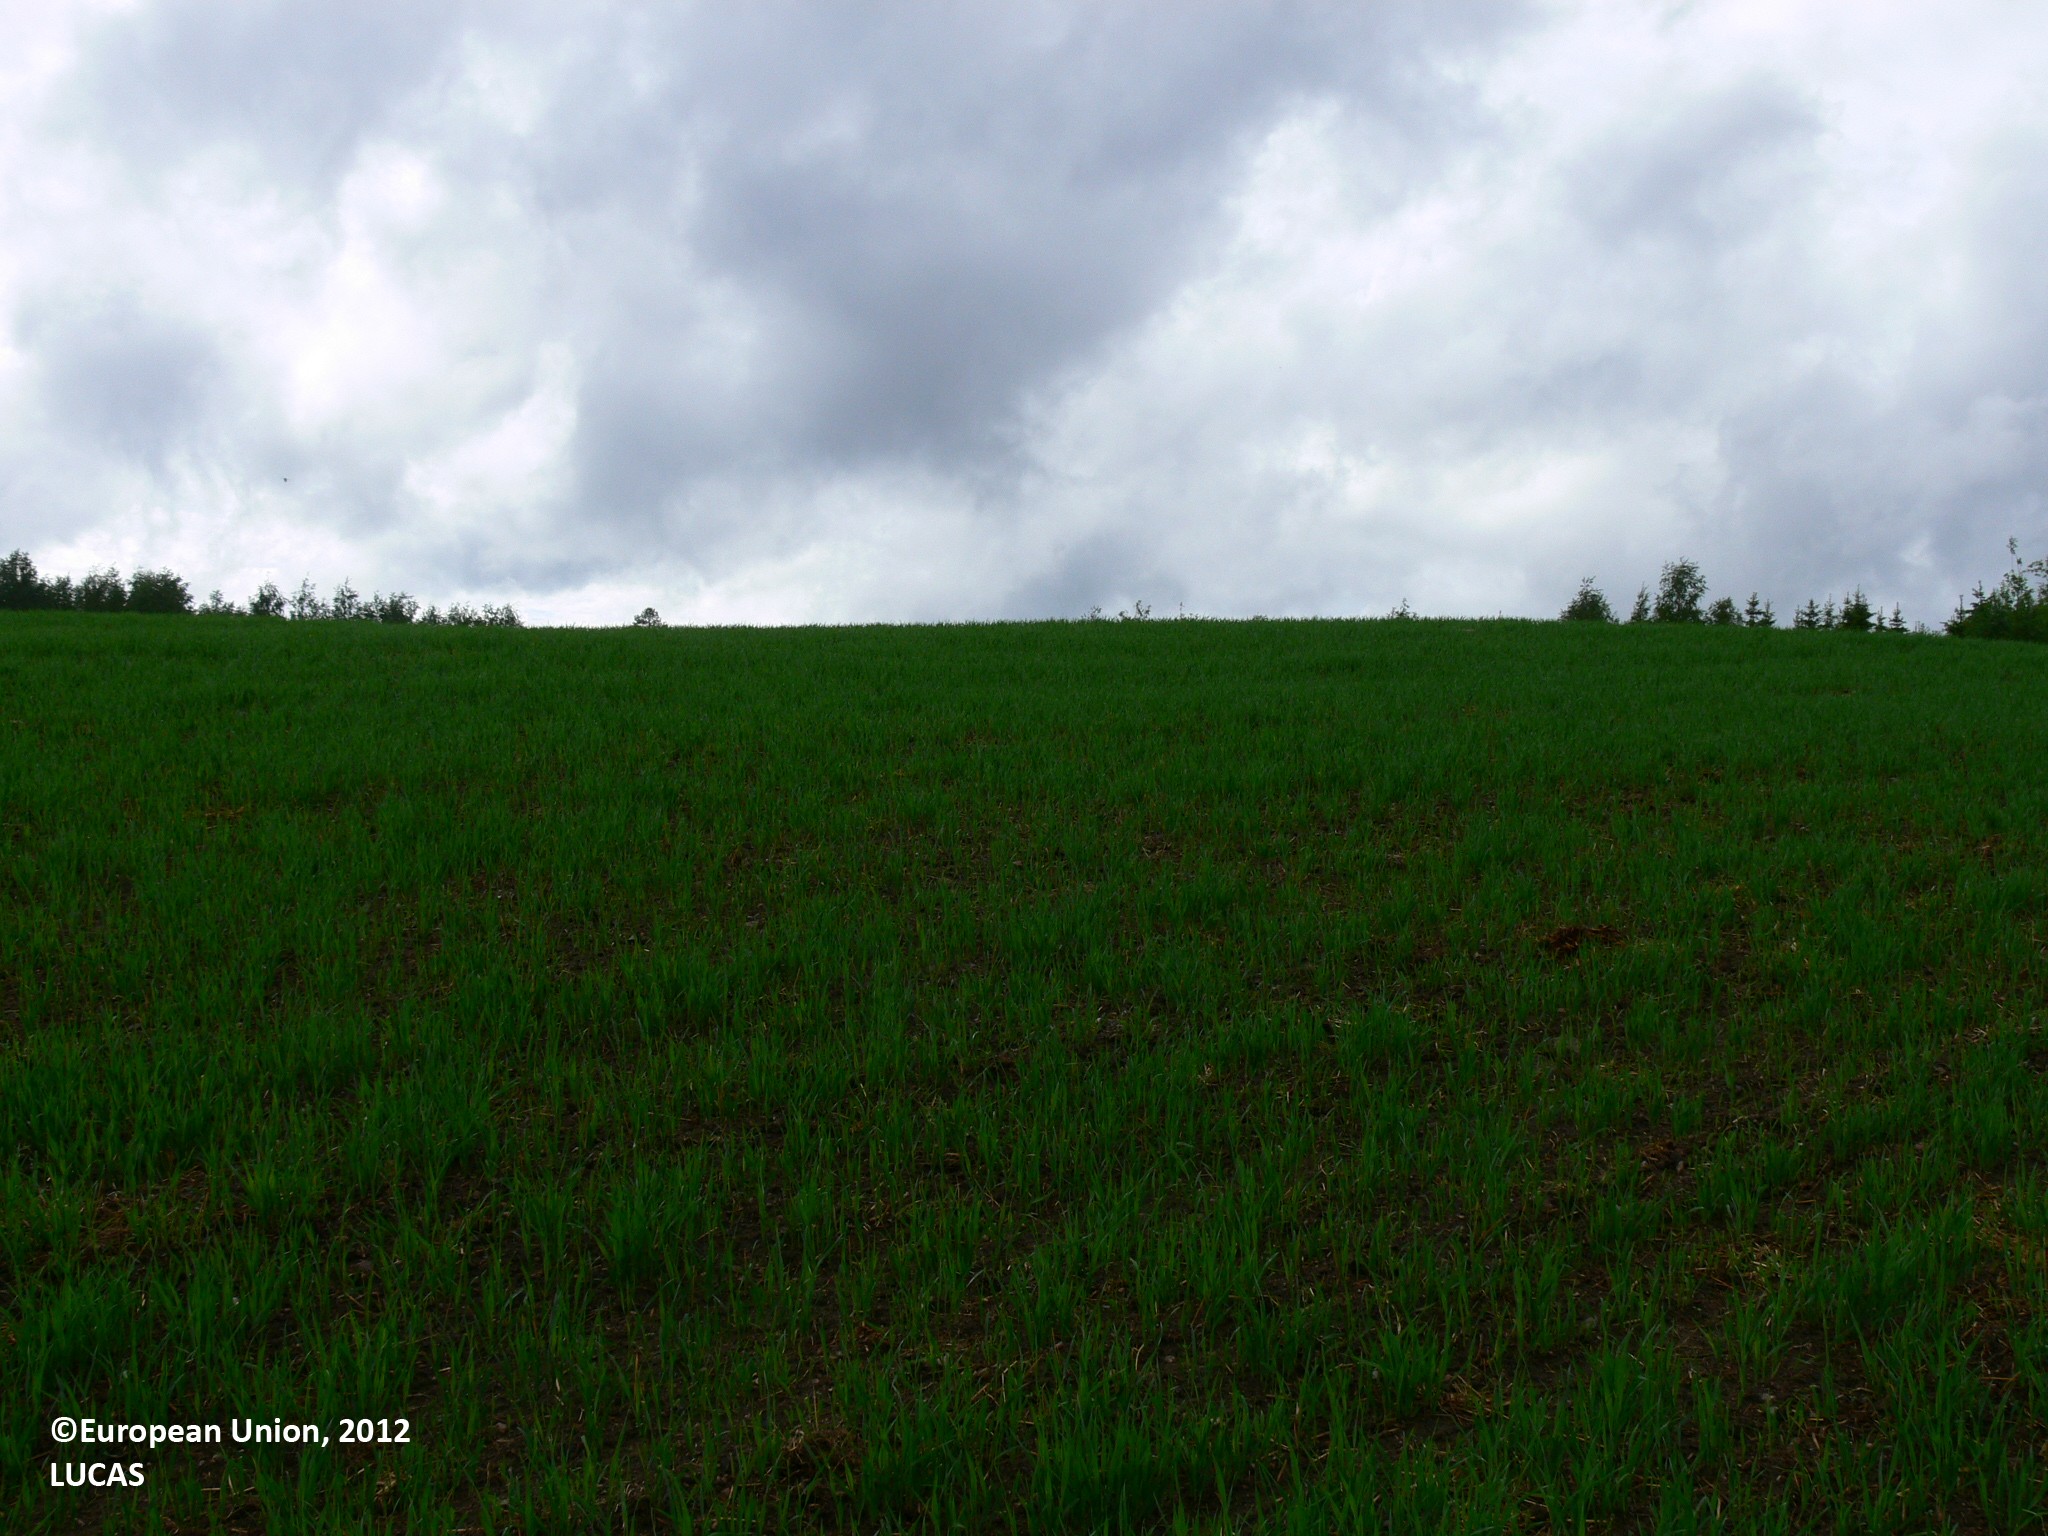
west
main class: Cropland
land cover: Oats
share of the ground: 25 - 50 %
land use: Agriculture (excluding fallow land and kitchen gardens)
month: June
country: FI
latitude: 62.4221
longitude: 30.4365
